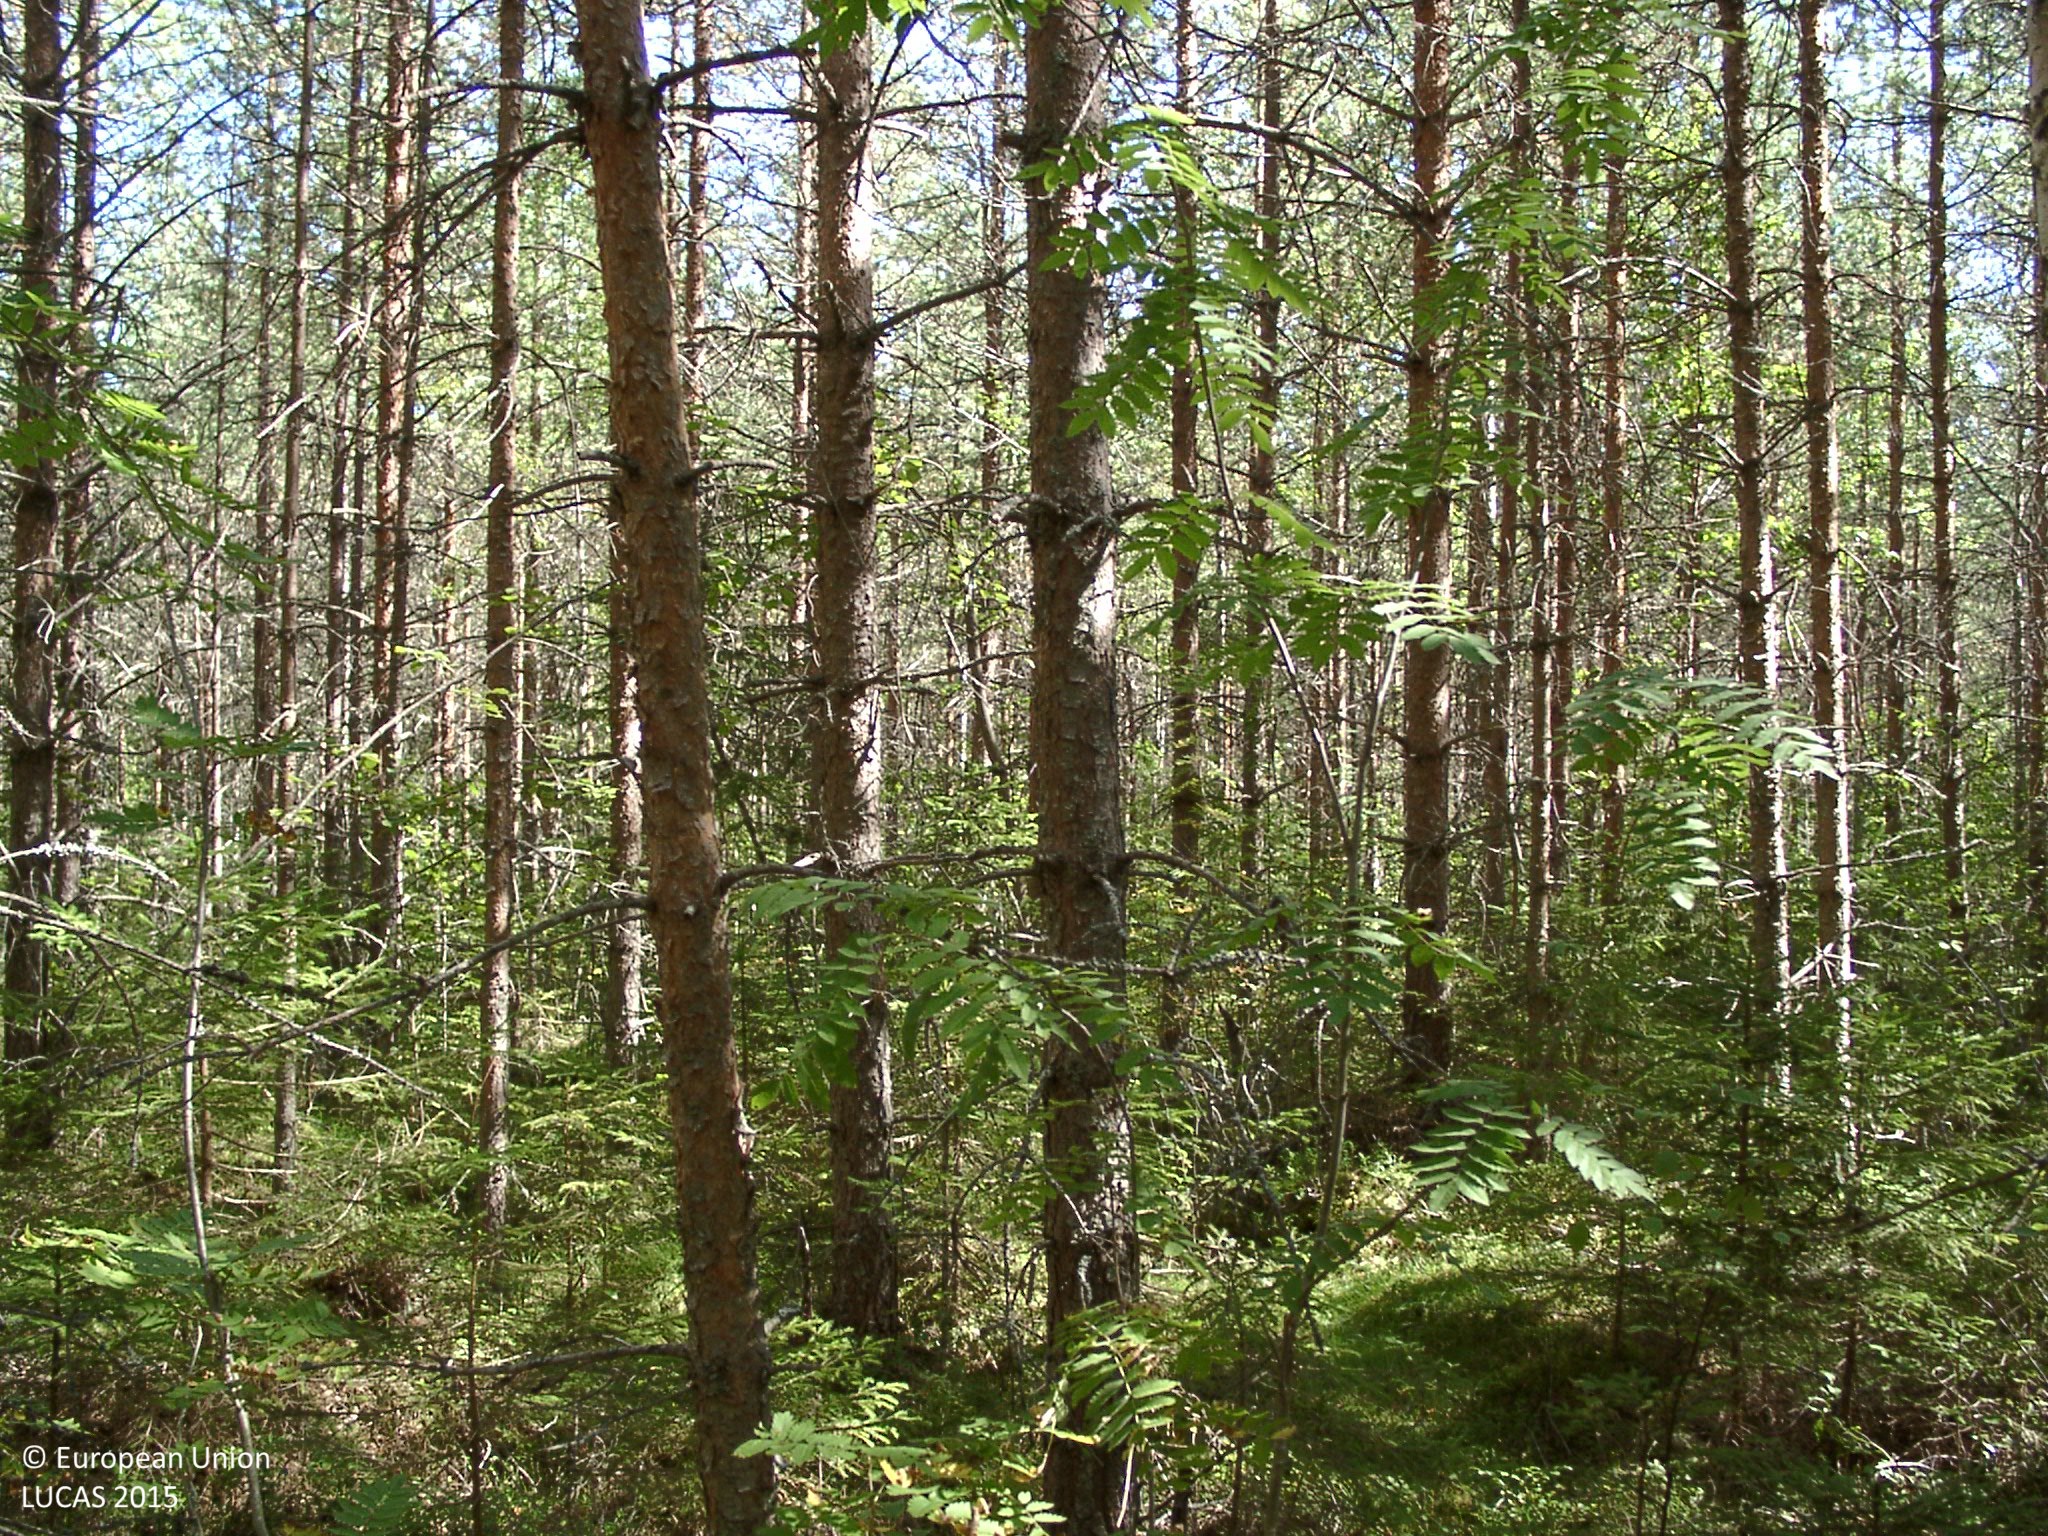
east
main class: Woodland
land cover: Pine dominated coniferous woodland
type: boreal forest
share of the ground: > 75 %
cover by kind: coniferous forest trees 75 %, broadleaved forest trees 10 %, shrubs 10 %, herbaceous plants 5 %
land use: Forestry
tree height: > 5 m
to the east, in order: Pine dominated coniferous woodland; Ditches and canals; Pine dominated mixed woodland; Groves; Ditches and canals; Spruce dominated mixed woodland; Ditches and canals; Spruce dominated mixed woodland; Shruby margins; Spruce dominated coniferous woodland; Shruby margins; Spruce dominated coniferous woodland; Shruby margins; Spruce dominated coniferous woodland
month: August
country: FI
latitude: 62.4423
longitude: 25.1985
